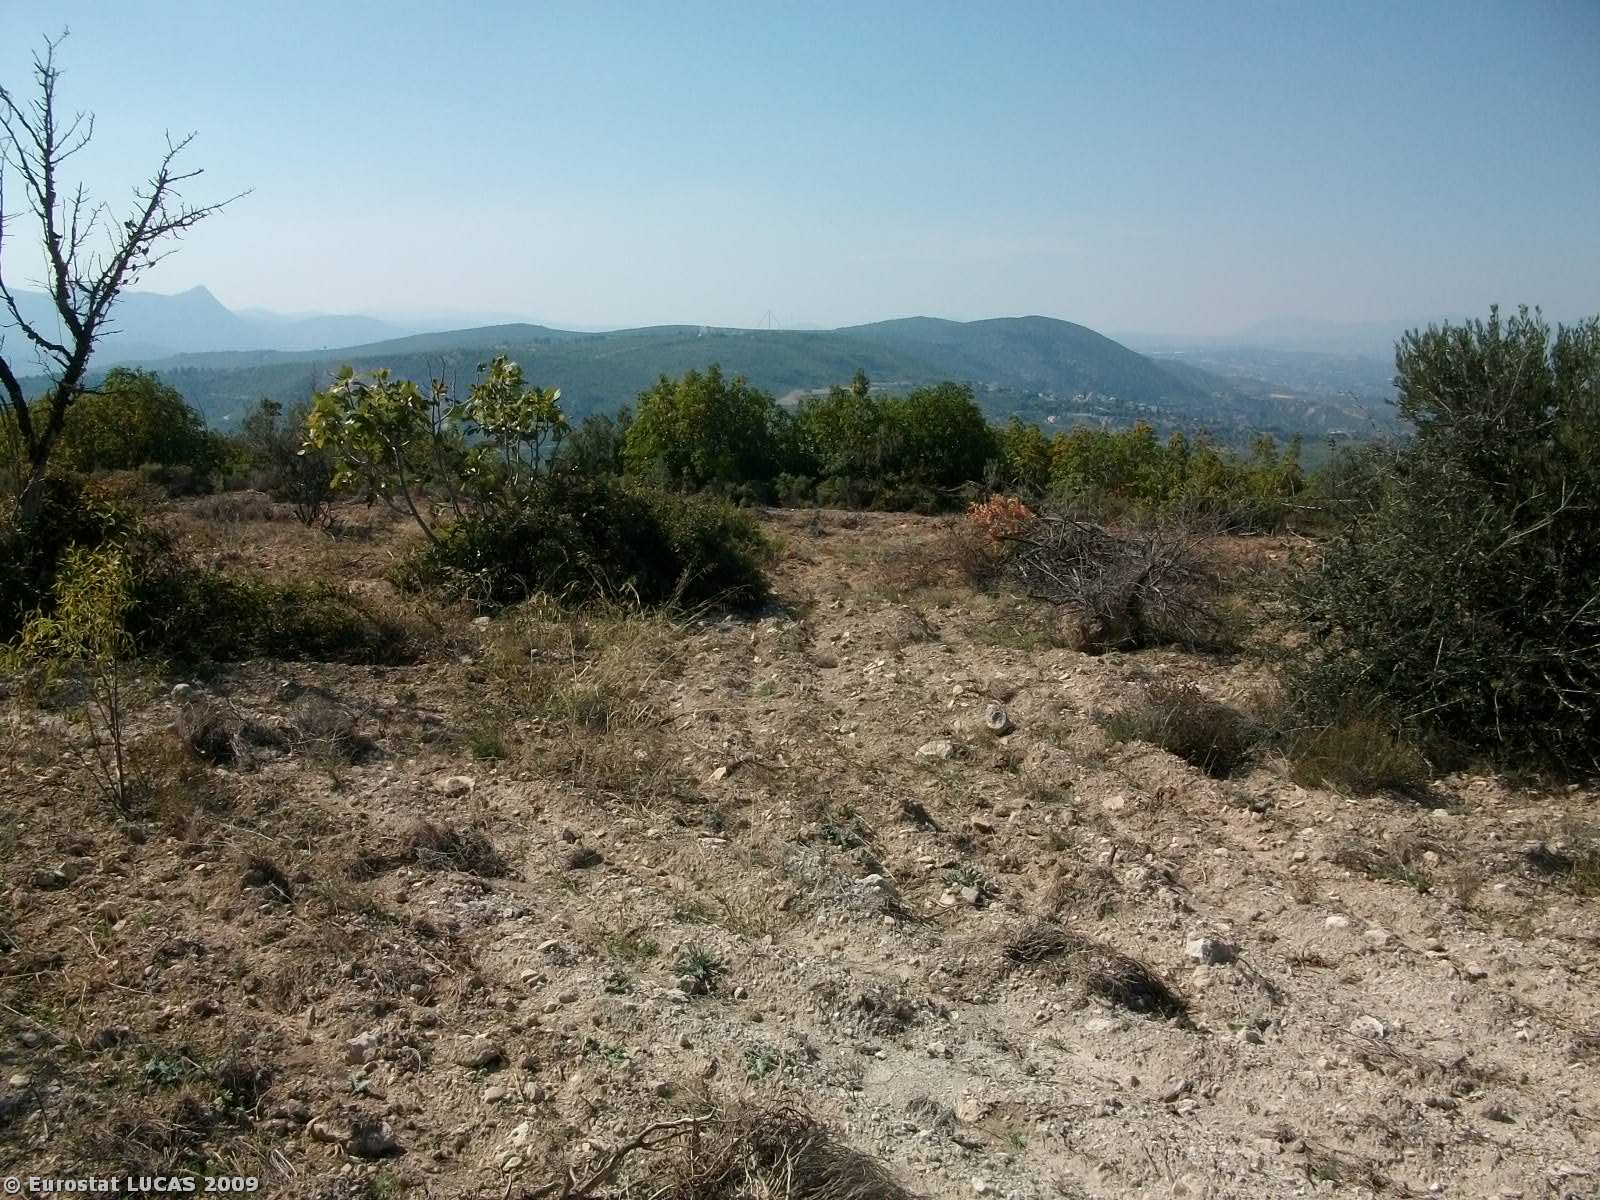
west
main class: Cropland
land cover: Olive groves
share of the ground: < 10 %
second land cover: Grassland with sparse tree/shrub cover
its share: 50 - 75 %
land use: Agriculture (excluding fallow land and kitchen gardens)
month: September
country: GR
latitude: 38.2742
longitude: 23.8285
